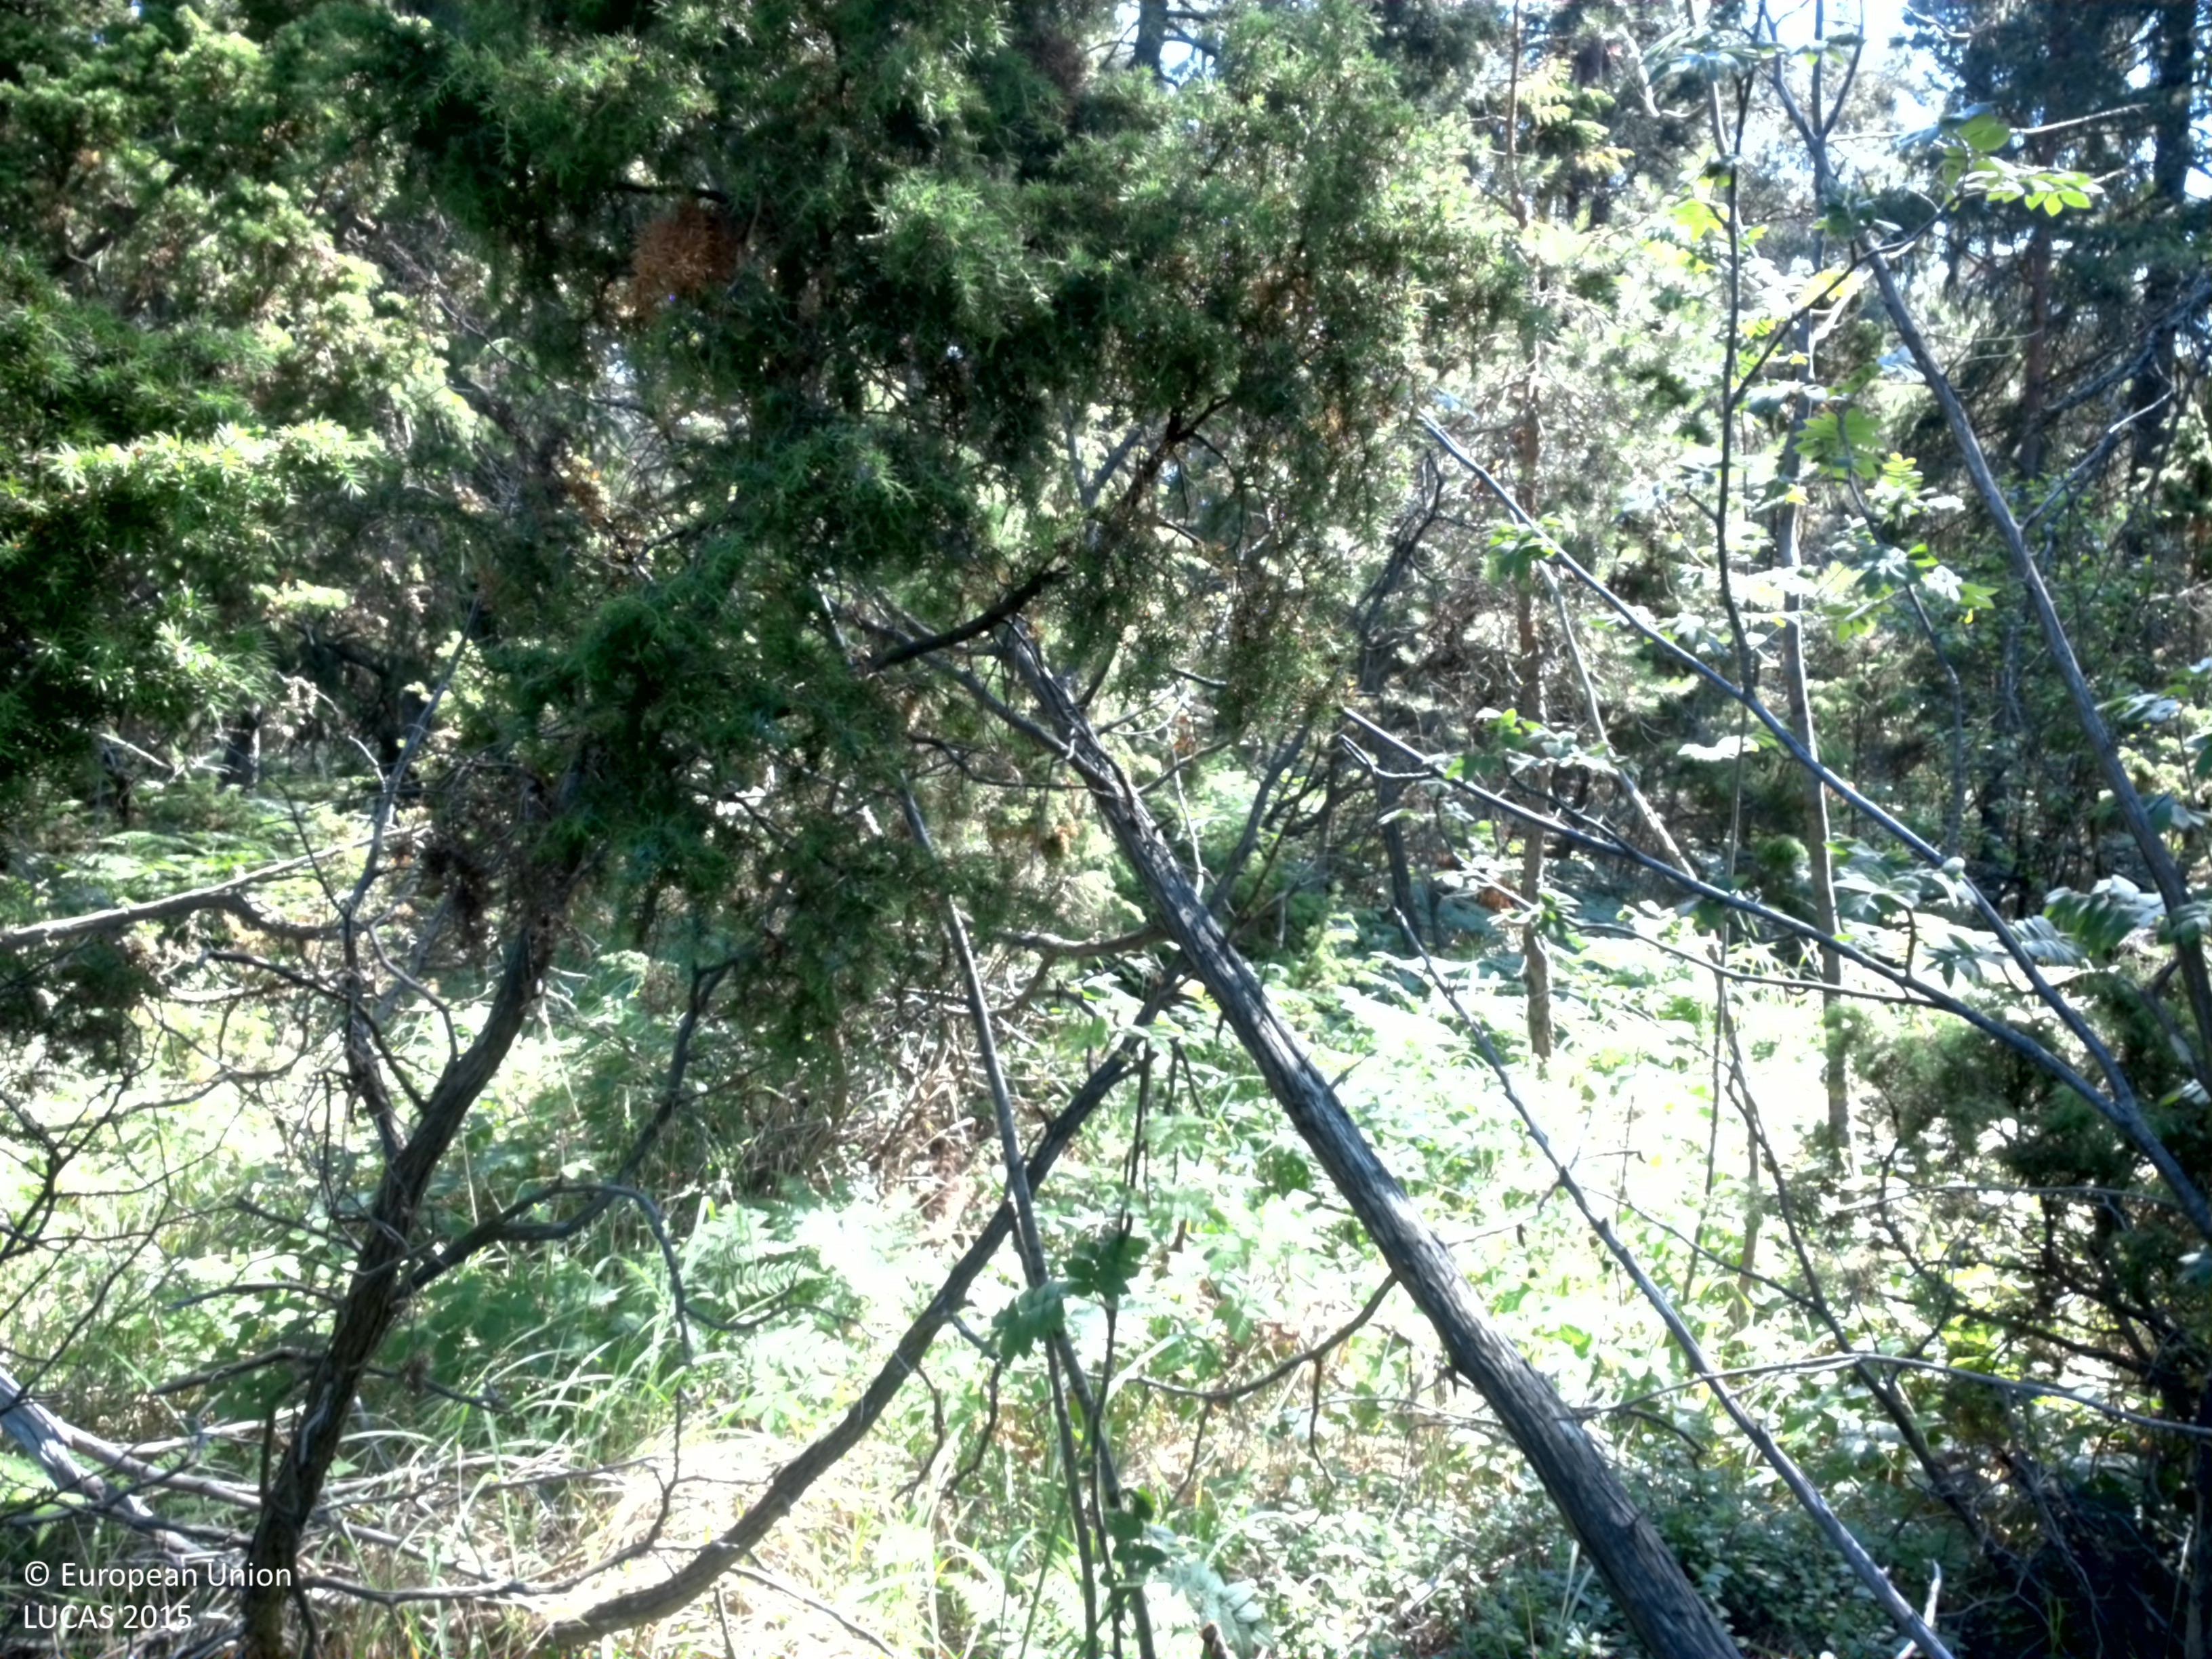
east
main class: Woodland
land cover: Pine dominated coniferous woodland
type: hemiboreal forest and nemoral coniferous forest and mixed broadleaved-coniferous forest
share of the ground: > 75 %
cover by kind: coniferous forest trees 70 %, broadleaved forest trees 15 %, shrubs 15 %
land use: Forestry
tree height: > 5 m
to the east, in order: Pine dominated coniferous woodland; Grassland with sparse tree/shrub cover
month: July
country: SE
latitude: 57.7649
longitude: 18.5640
